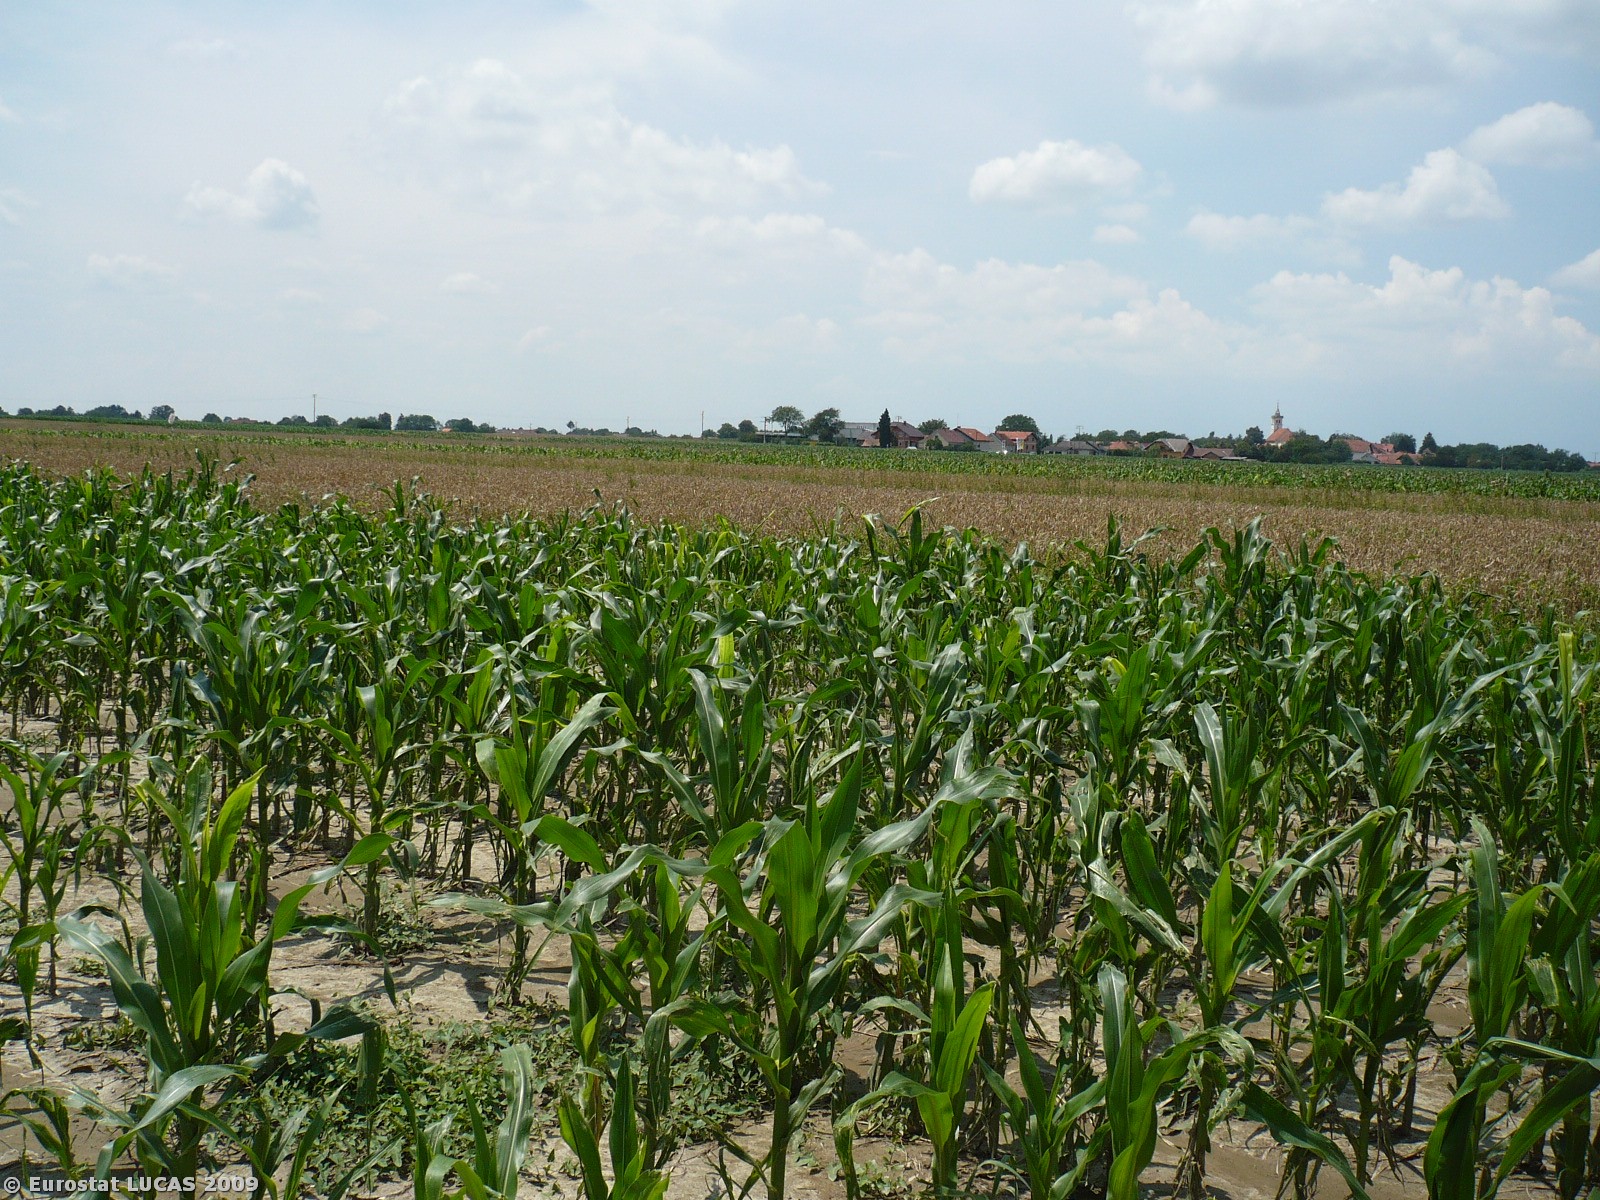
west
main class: Cropland
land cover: Maize
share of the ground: 50 - 75 %
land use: Agriculture (excluding fallow land and kitchen gardens)
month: July
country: SI
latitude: 46.6494
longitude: 16.3643
